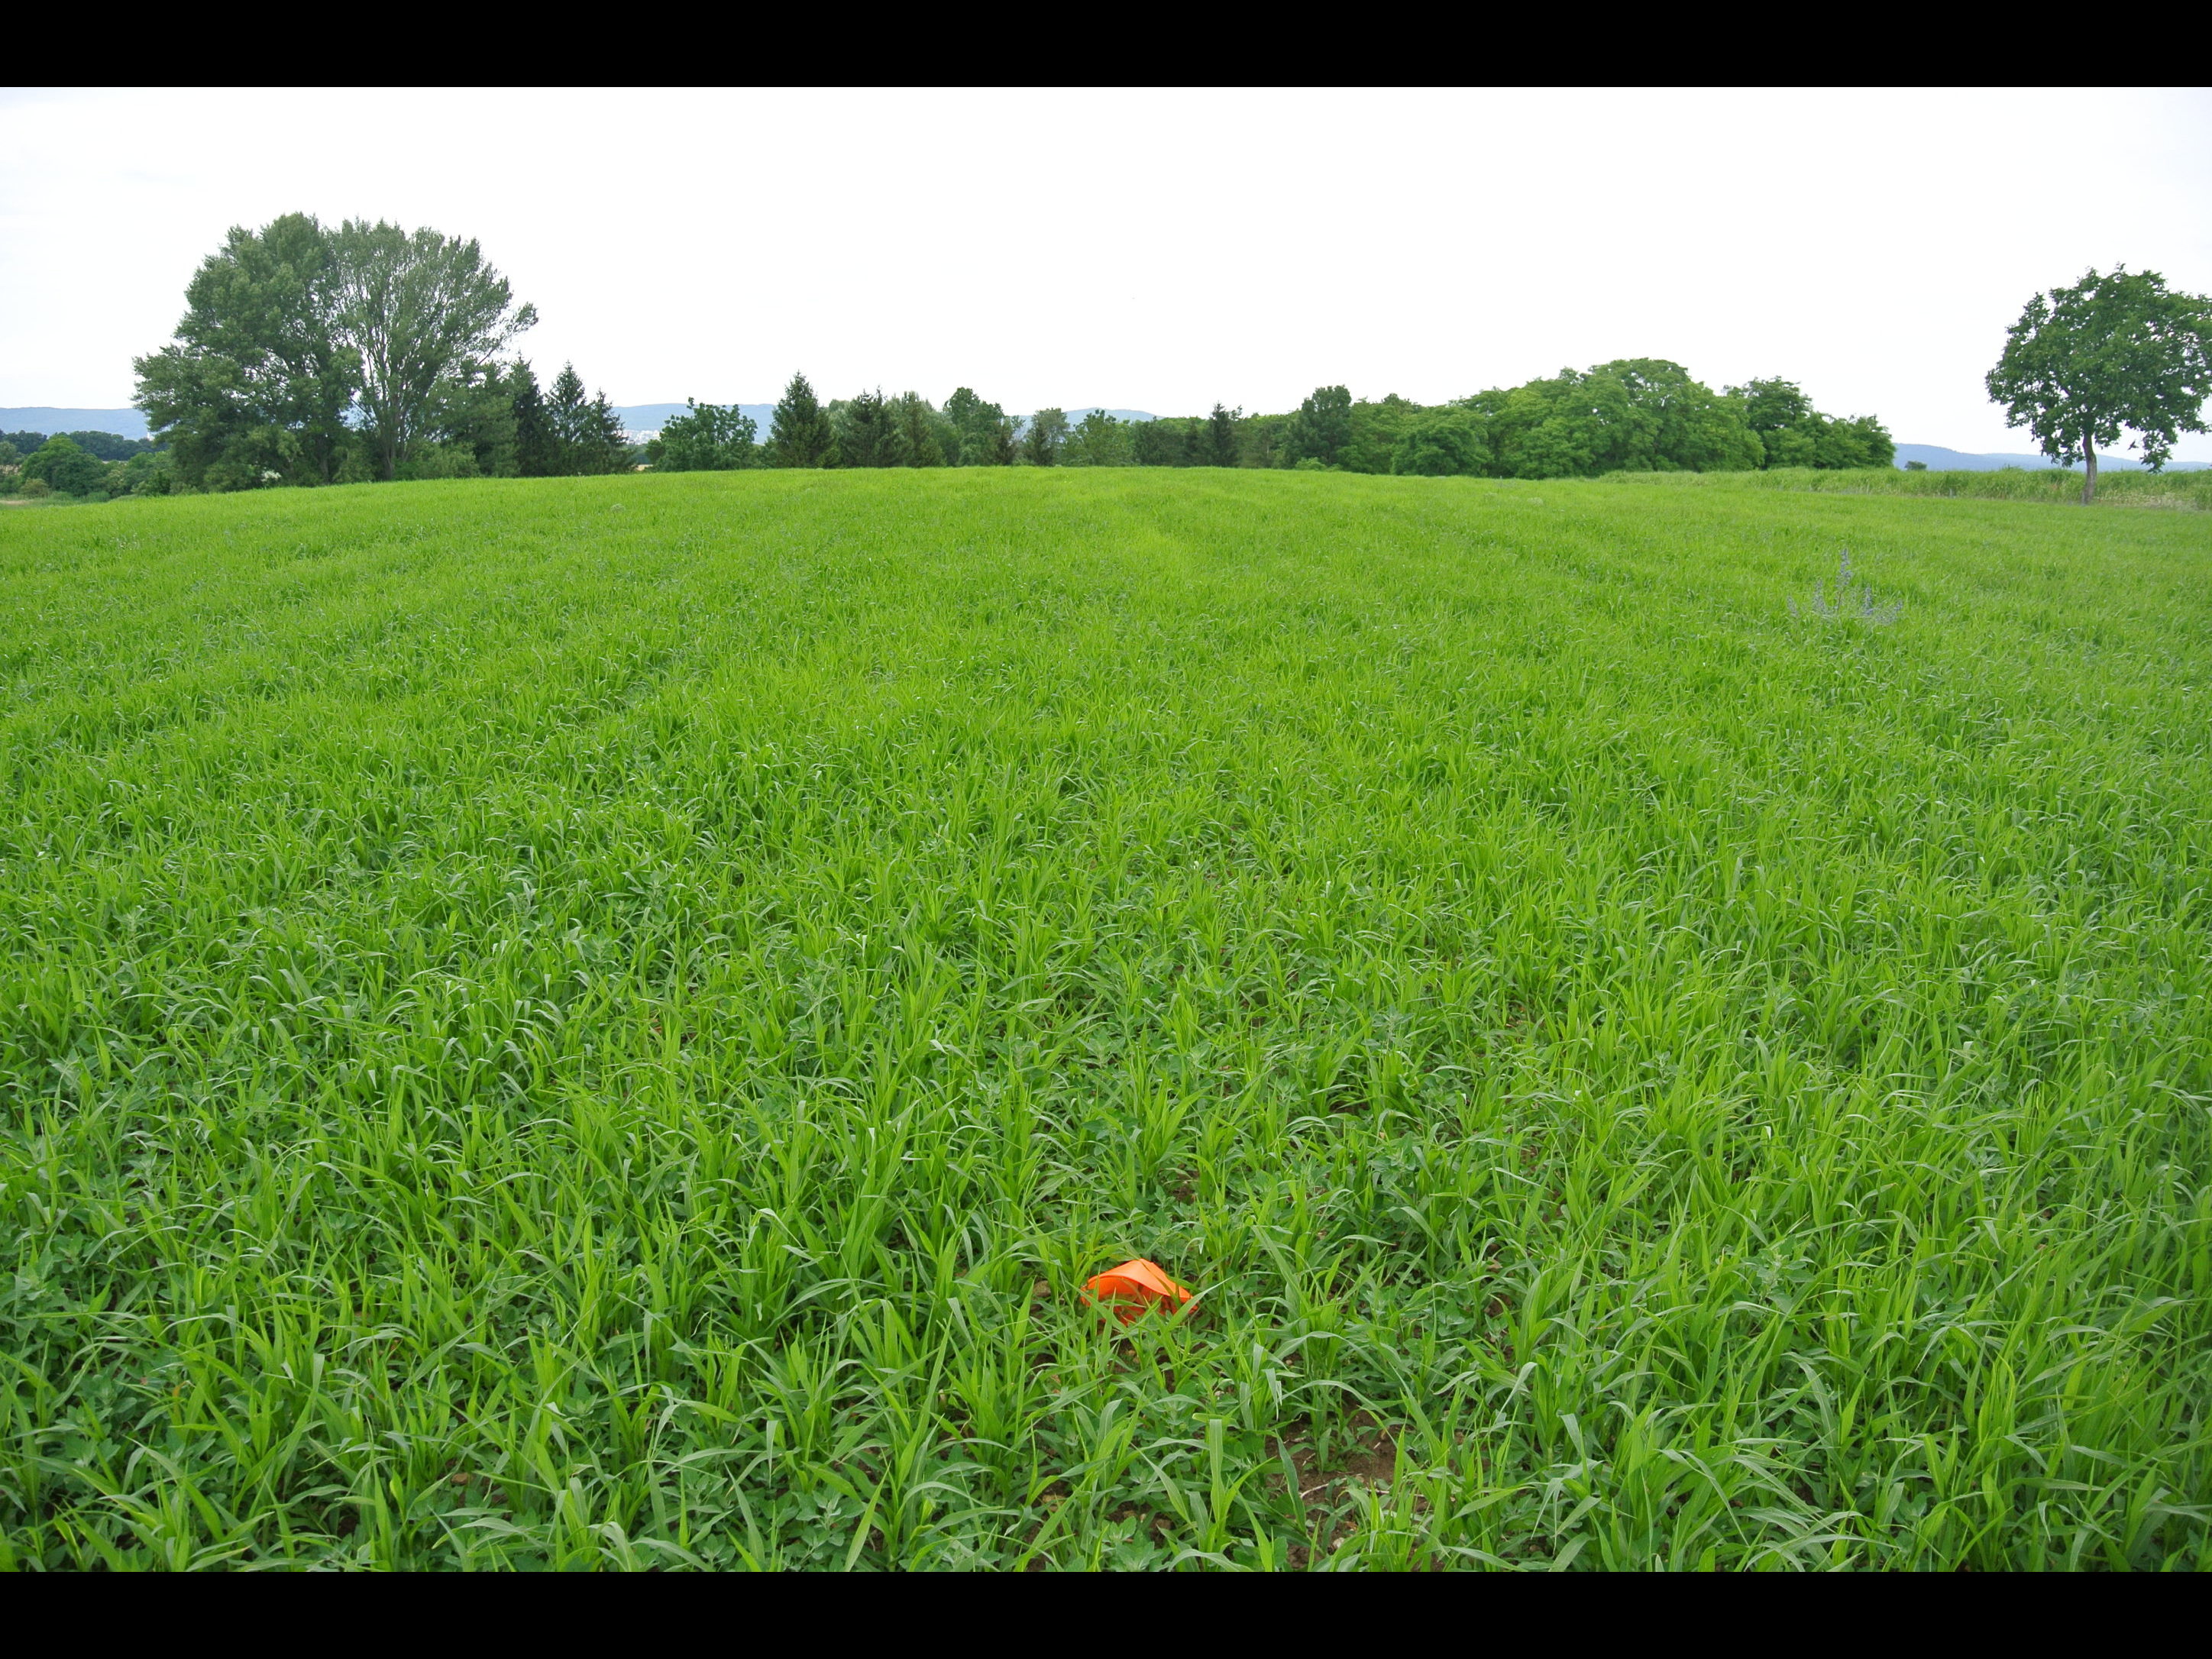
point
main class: Cropland
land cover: Common wheat
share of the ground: > 75 %
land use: Agriculture (excluding fallow land and kitchen gardens)
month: June
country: AT
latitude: 47.7918
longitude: 16.5860
